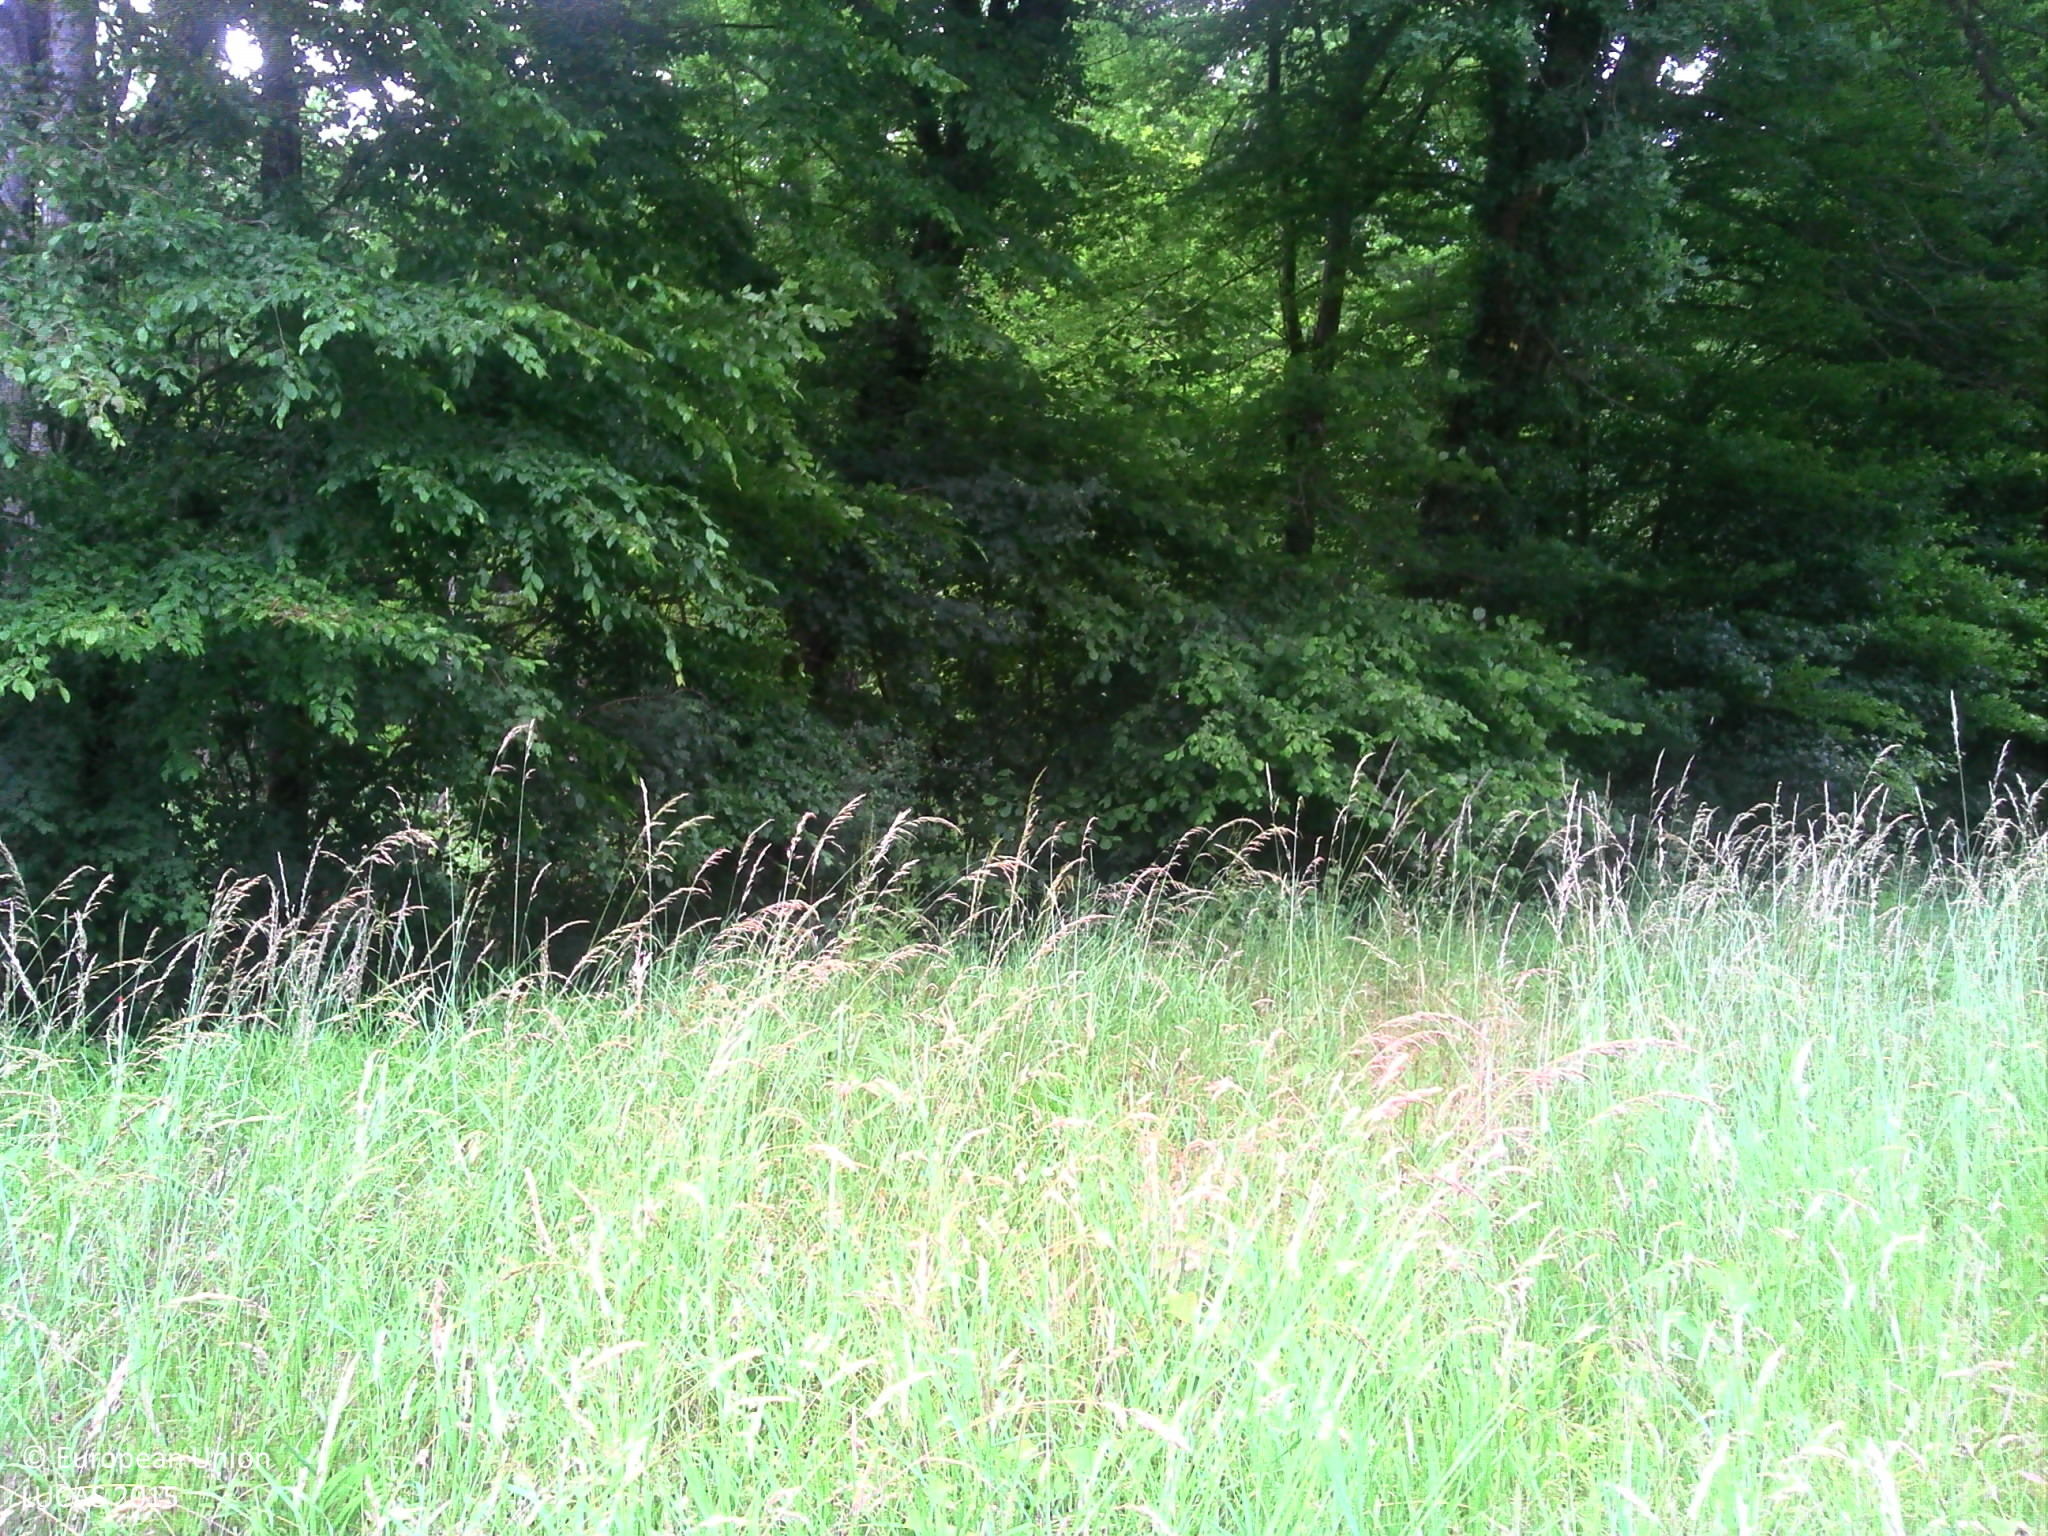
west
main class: Grassland
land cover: Grassland without tree/shrub cover
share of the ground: > 75 %
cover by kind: herbaceous plants 100 %
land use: Agriculture (excluding fallow land and kitchen gardens)
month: June
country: FR
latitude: 48.3380
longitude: 4.8583
